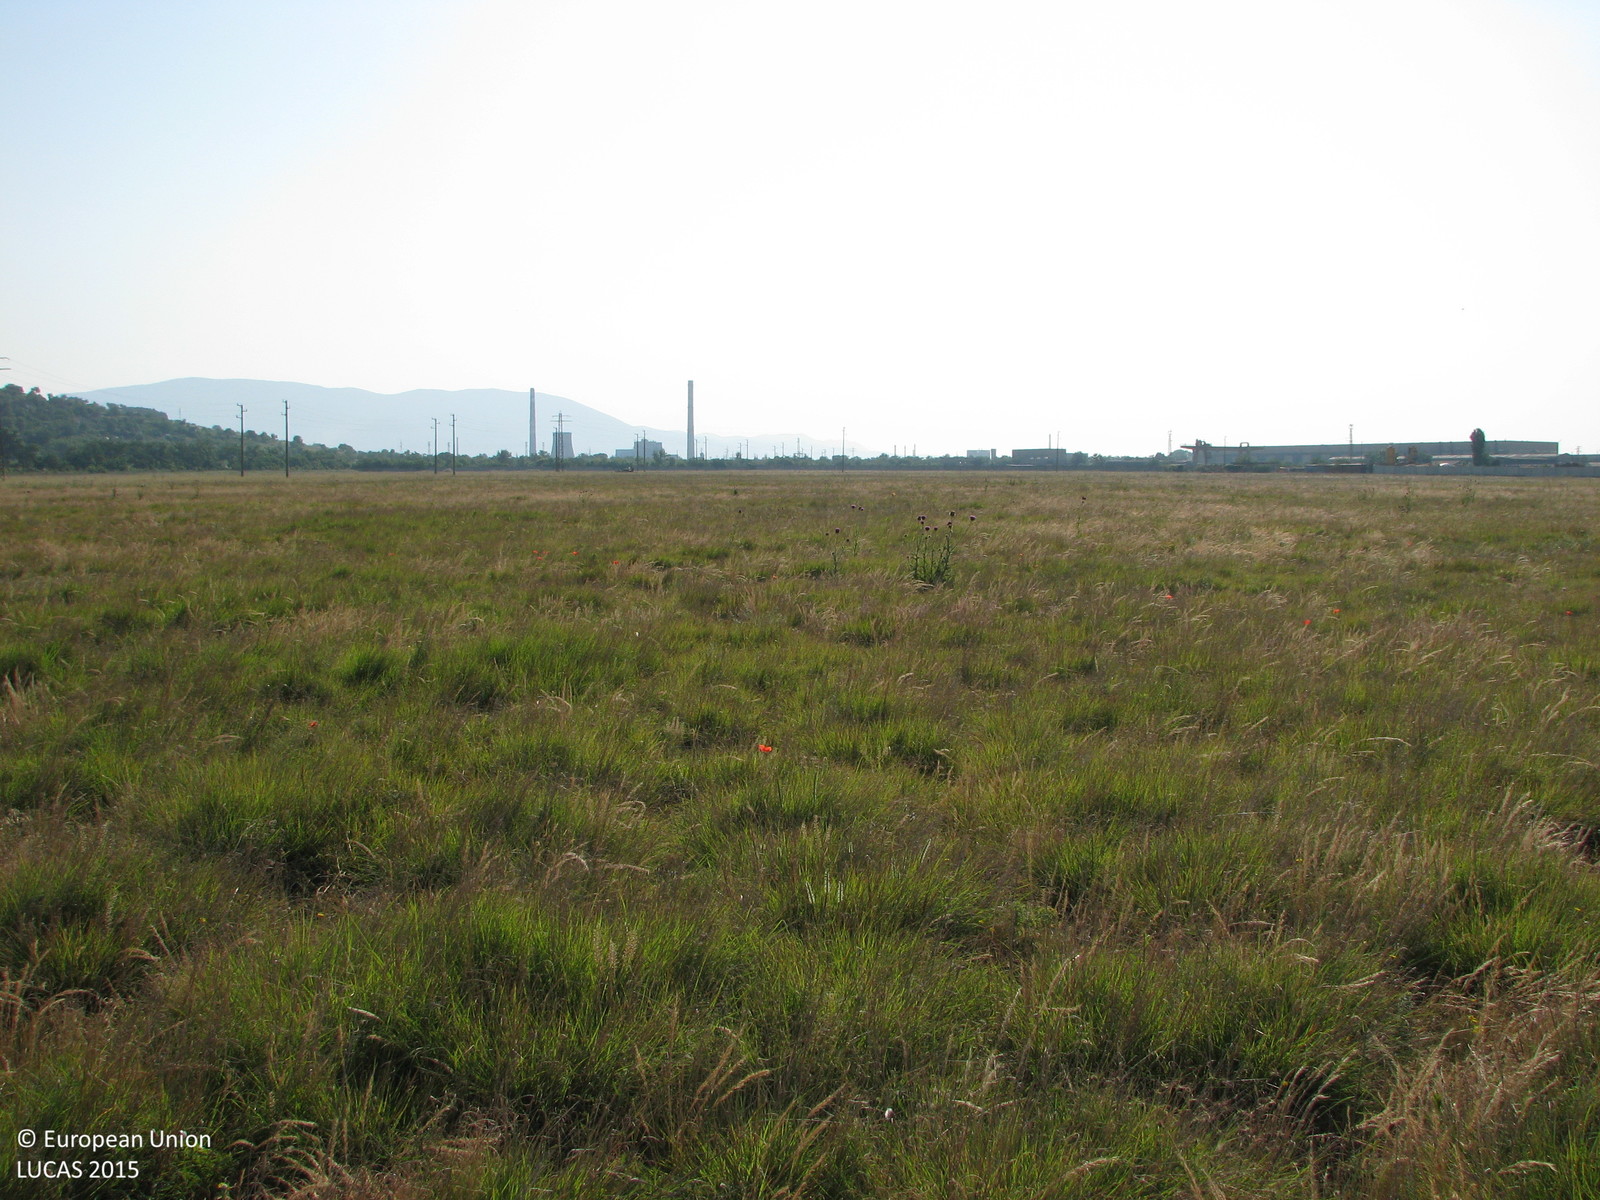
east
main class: Grassland
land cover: Grassland without tree/shrub cover
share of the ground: > 75 %
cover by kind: herbaceous plants 100 %
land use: Agriculture (excluding fallow land and kitchen gardens)
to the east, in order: Grassland without tree/shrub cover
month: June
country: BG
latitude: 42.6470
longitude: 26.2995
